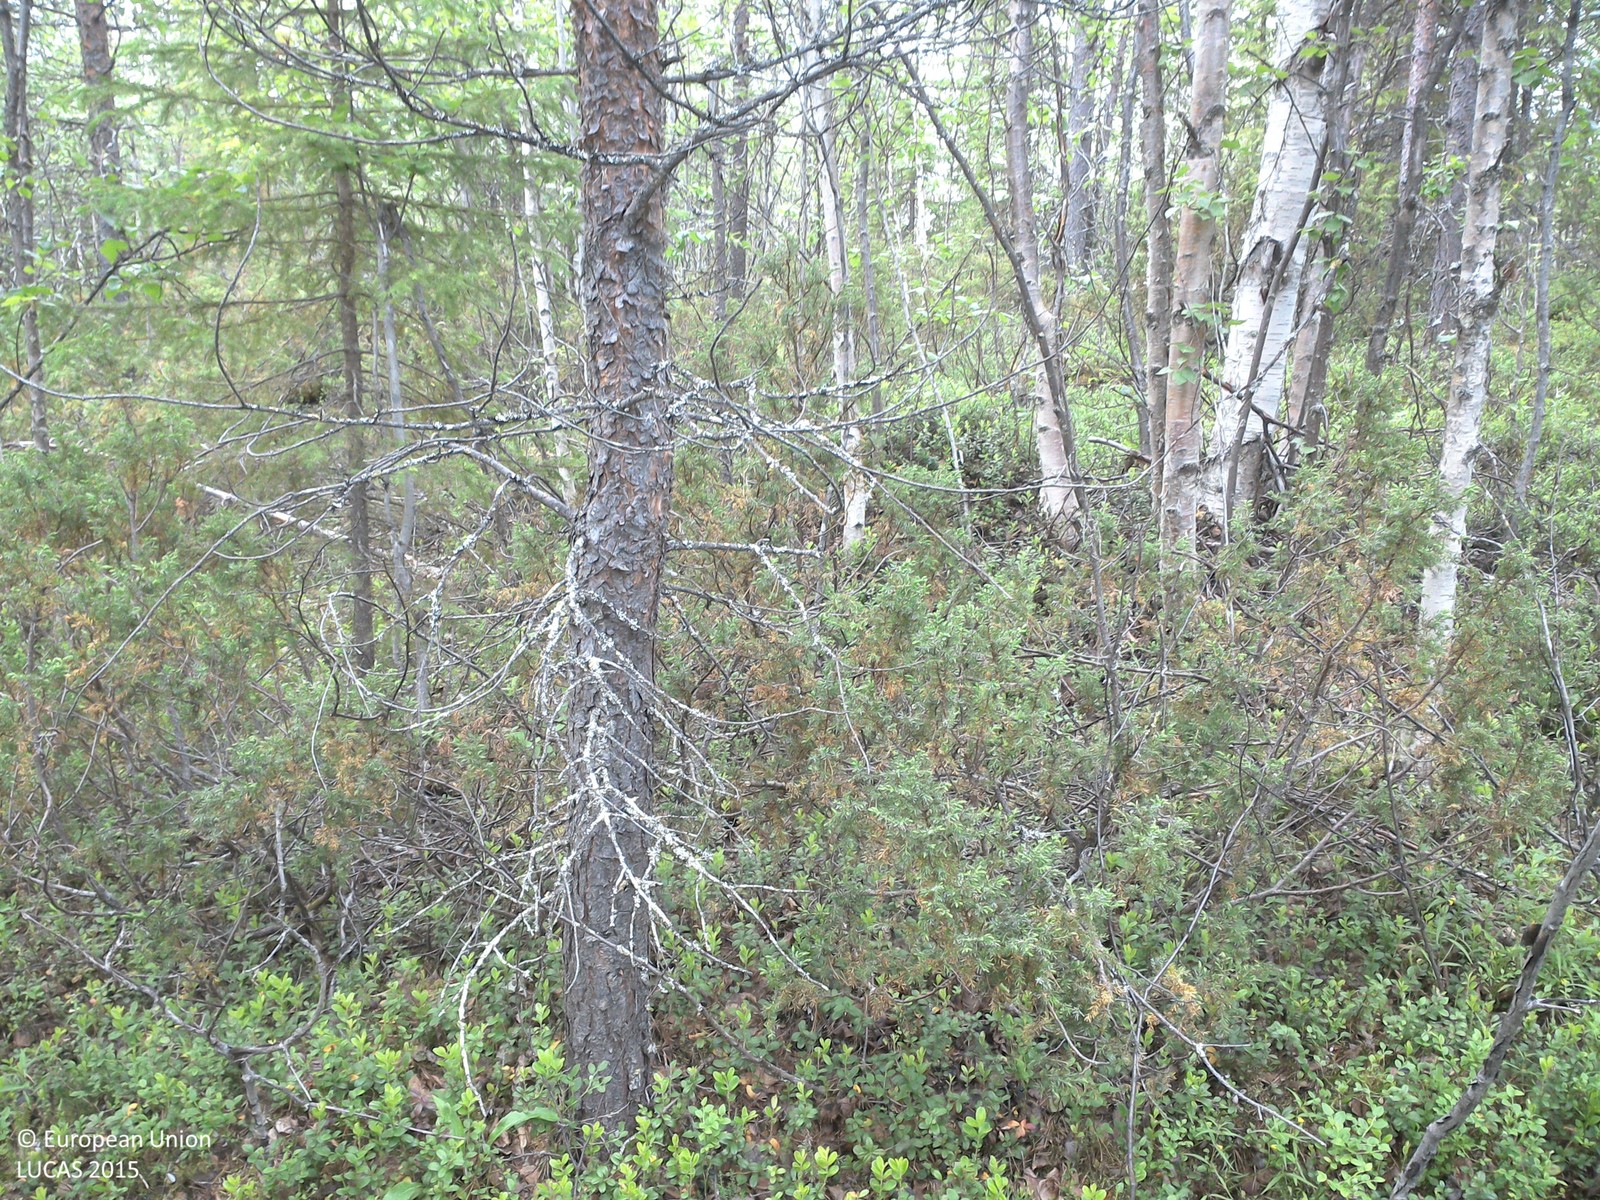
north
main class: Woodland
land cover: Pine dominated mixed woodland
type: boreal forest
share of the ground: 25 - 50 %
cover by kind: shrubs 55 %, coniferous forest trees 20 %, broadleaved forest trees 15 %, lichens and mosses 10 %
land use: Forestry
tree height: > 5 m
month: July
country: SE
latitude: 66.8476
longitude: 23.1251
